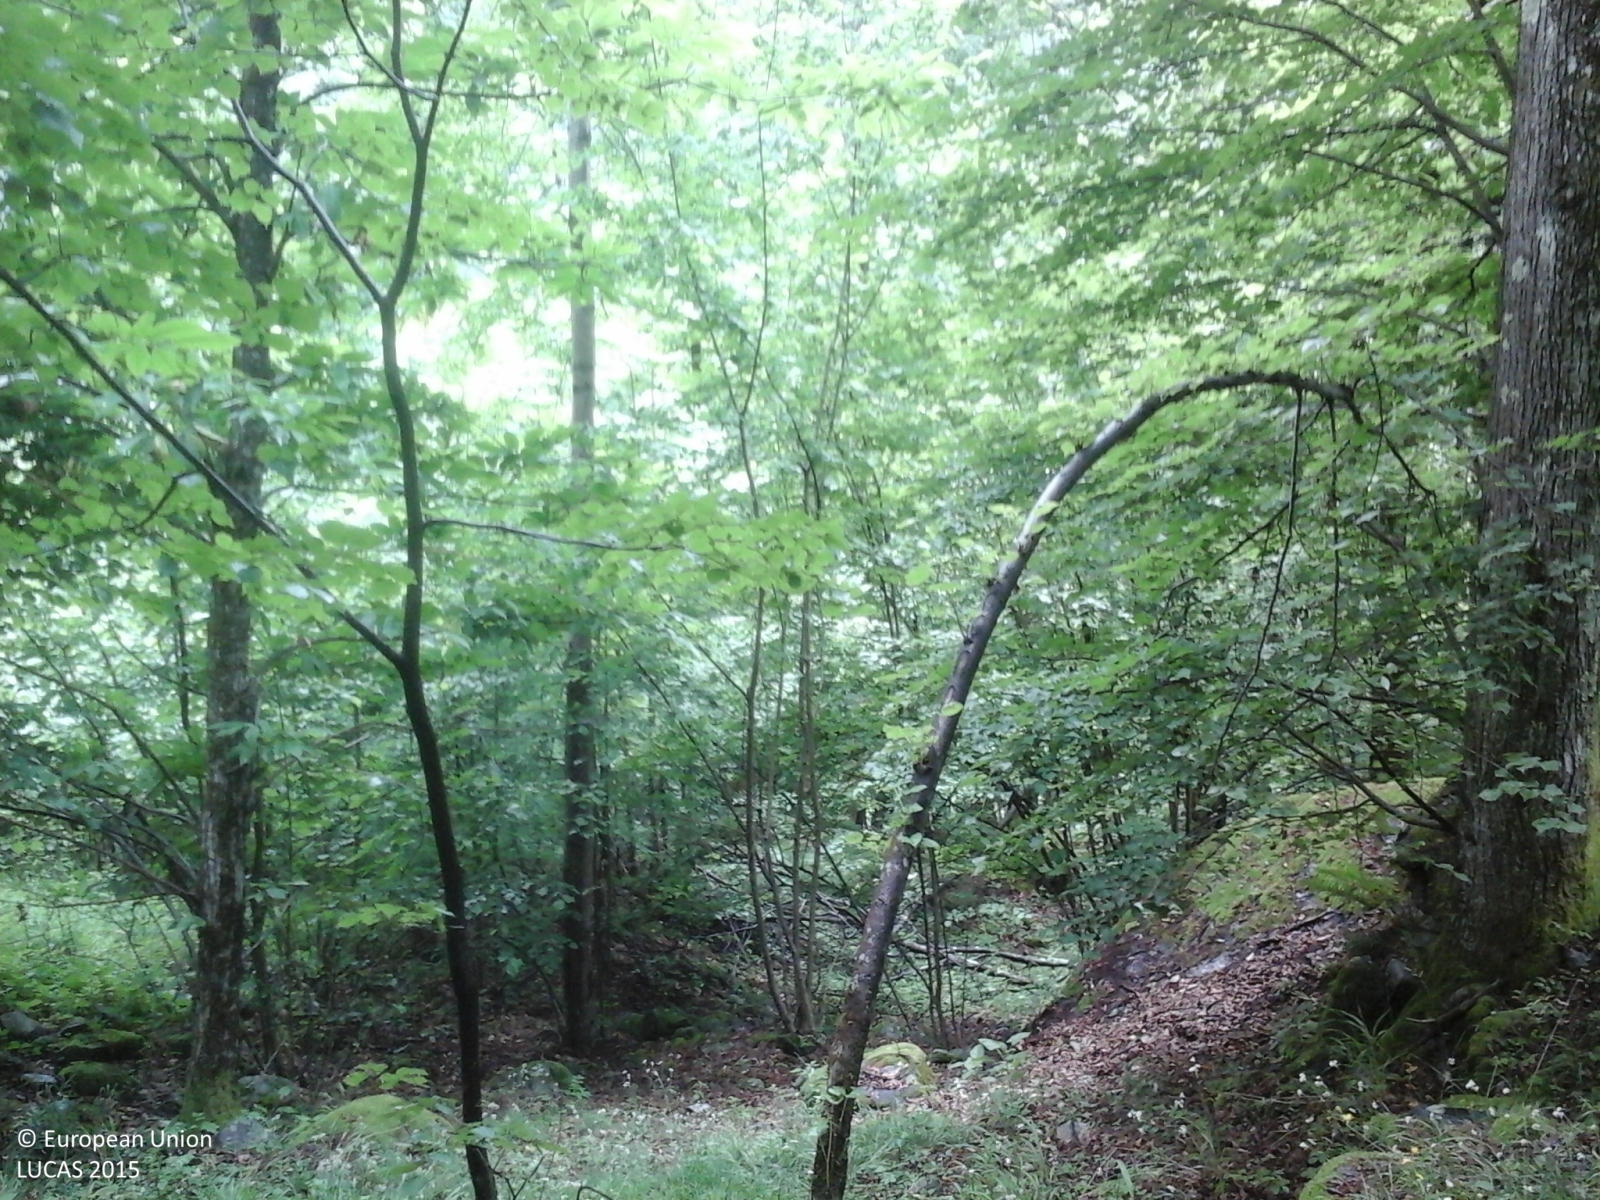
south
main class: Woodland
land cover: Broadleaved woodland
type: mesophytic deciduous forest
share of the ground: > 75 %
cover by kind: broadleaved forest trees 100 %
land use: Forestry
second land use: Amenities, museums, leisure
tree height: > 5 m
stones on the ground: 10 - 25 %
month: June
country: IT
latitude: 46.0470
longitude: 8.1545
